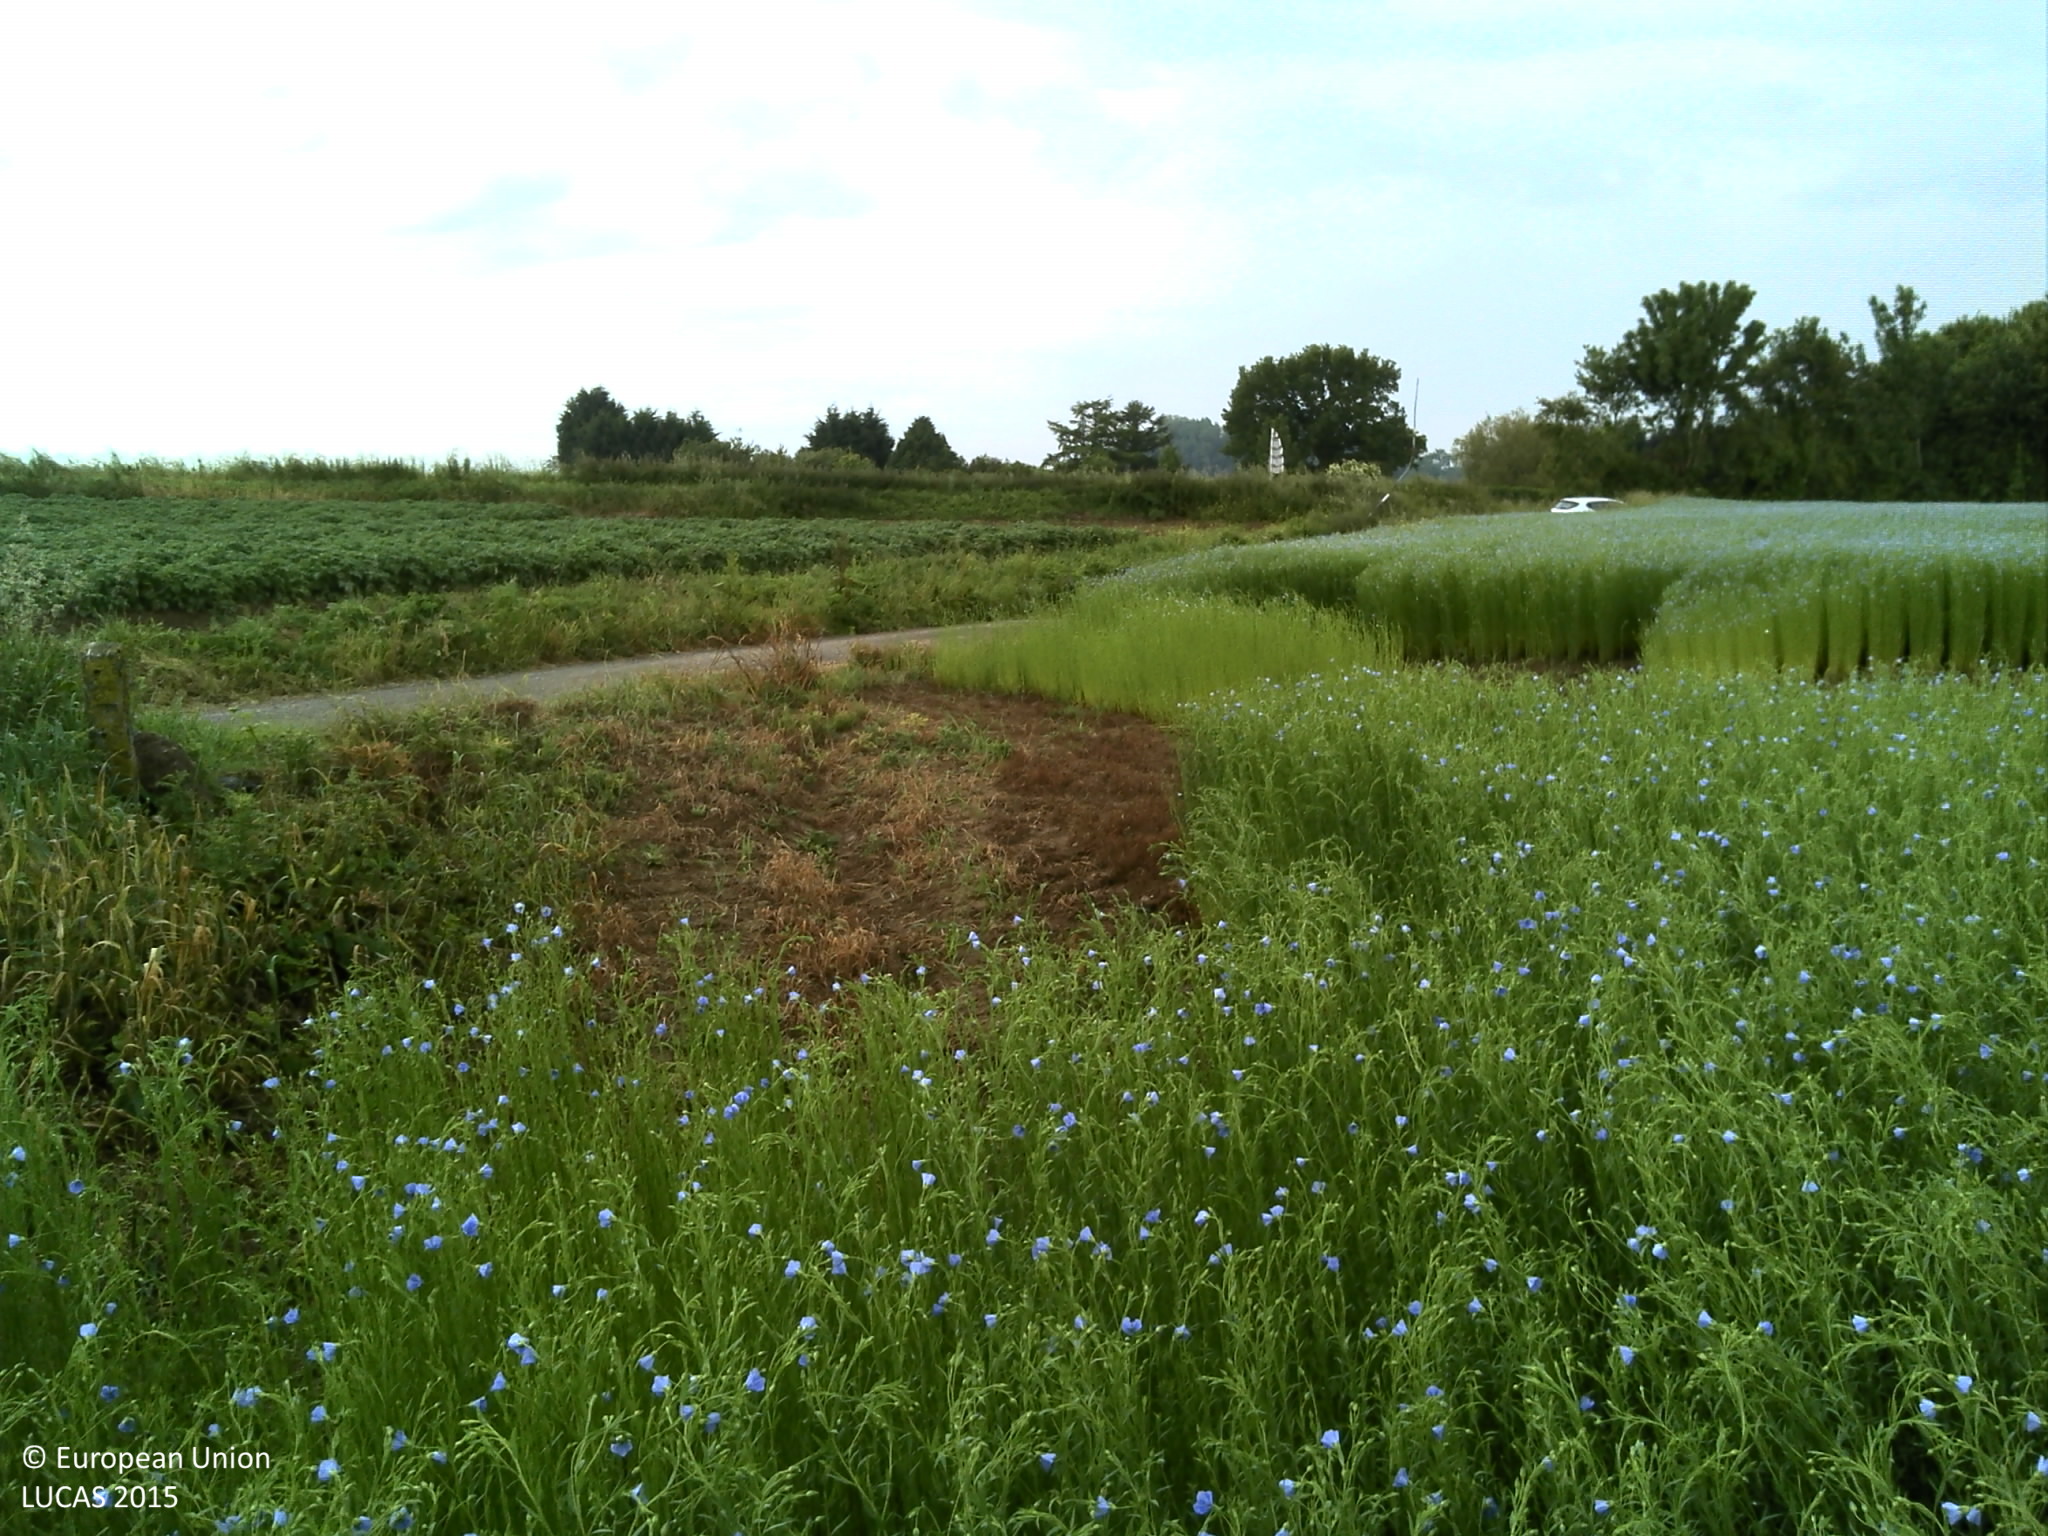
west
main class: Cropland
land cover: Other fibre and oleaginous crops
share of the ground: > 75 %
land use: Agriculture (excluding fallow land and kitchen gardens)
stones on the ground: < 10 %
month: June
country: FR
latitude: 49.5377
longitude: 0.3402
